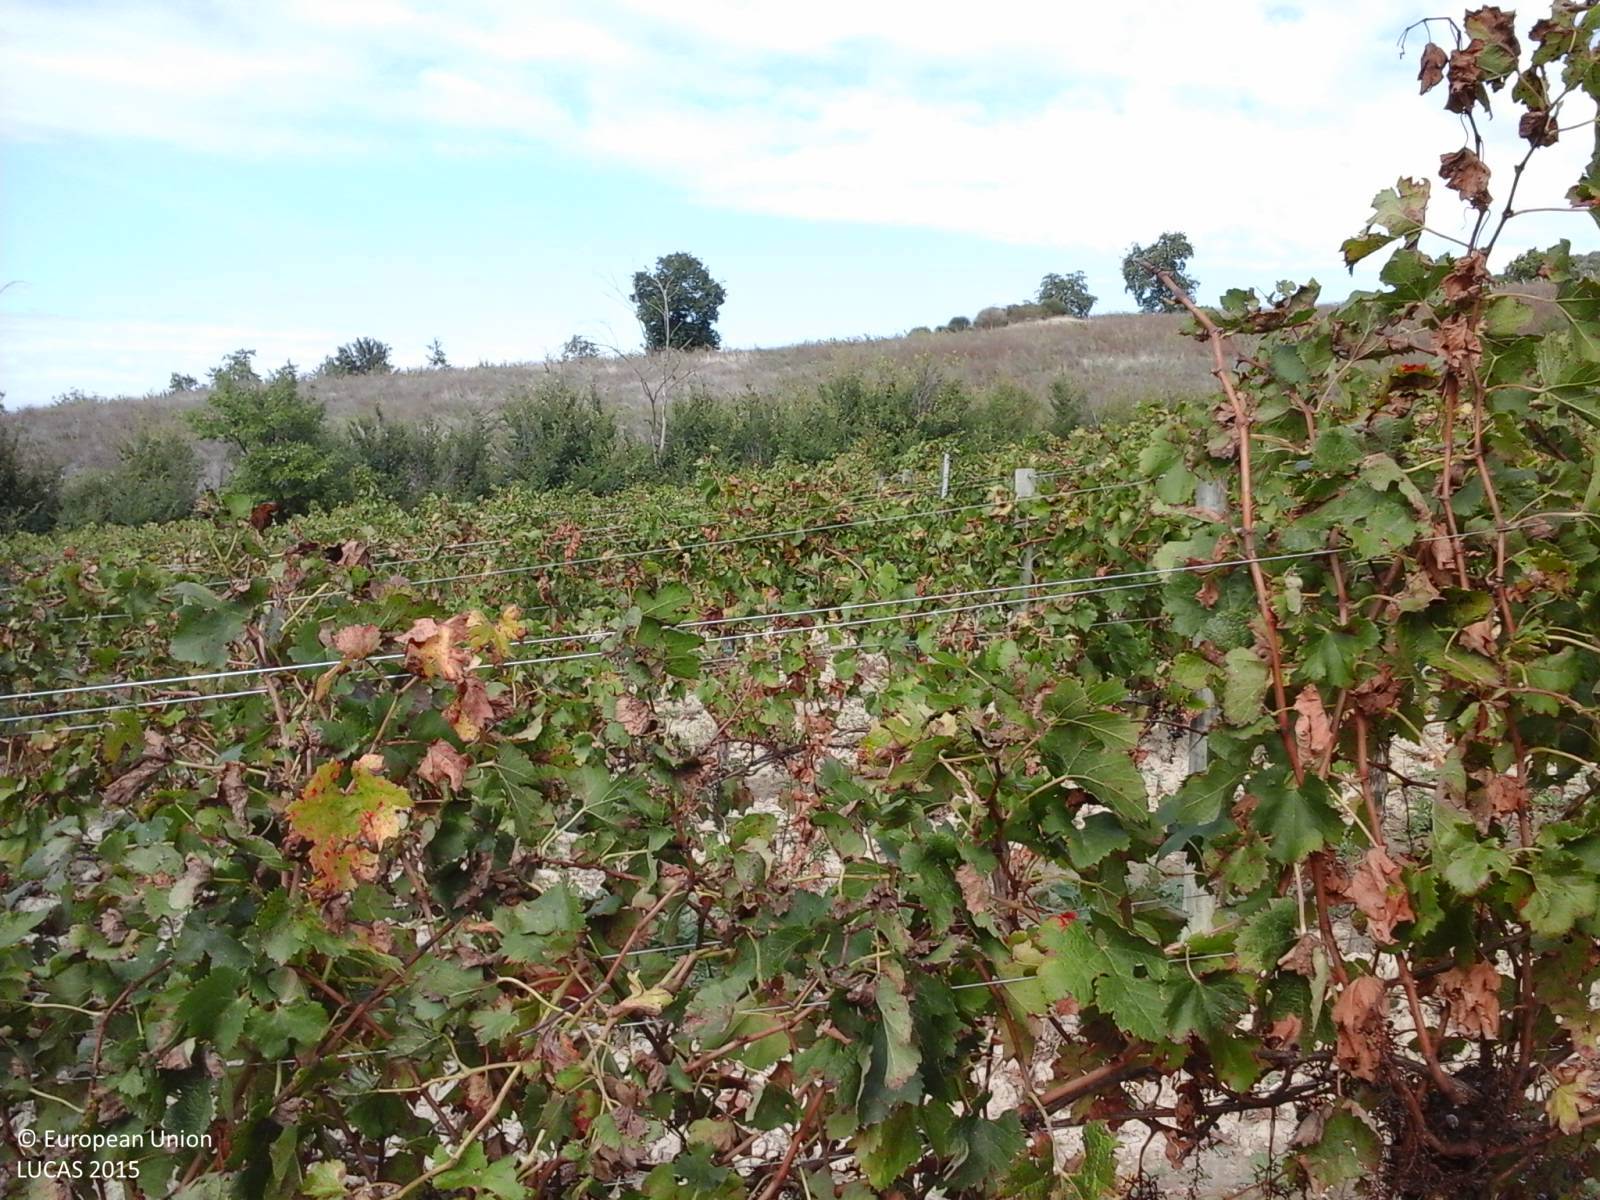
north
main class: Cropland
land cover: Vineyards
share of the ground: > 75 %
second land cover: Other bare soil
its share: > 75 %
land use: Agriculture (excluding fallow land and kitchen gardens)
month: October
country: IT
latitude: 42.6827
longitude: 12.2749
